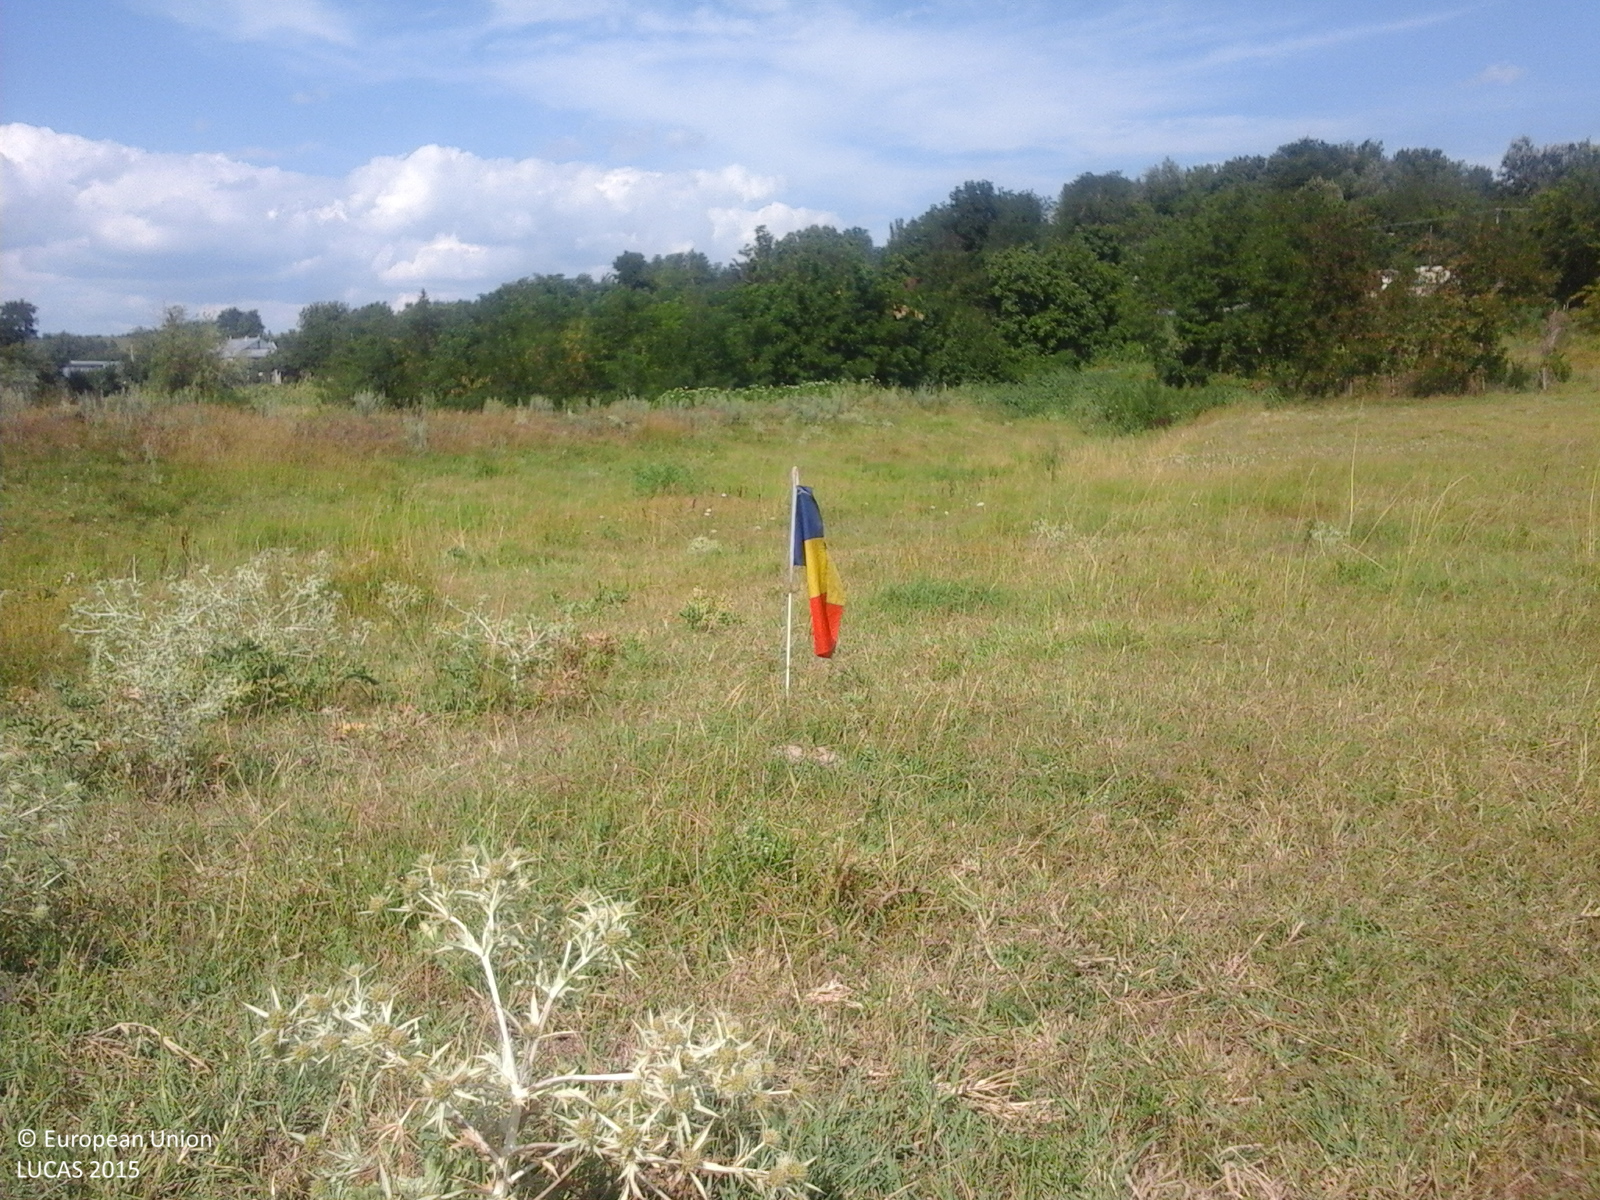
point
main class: Grassland
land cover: Grassland without tree/shrub cover
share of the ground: > 75 %
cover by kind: herbaceous plants 100 %
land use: Agriculture (excluding fallow land and kitchen gardens)
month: July
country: RO
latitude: 46.4963
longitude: 27.8278
